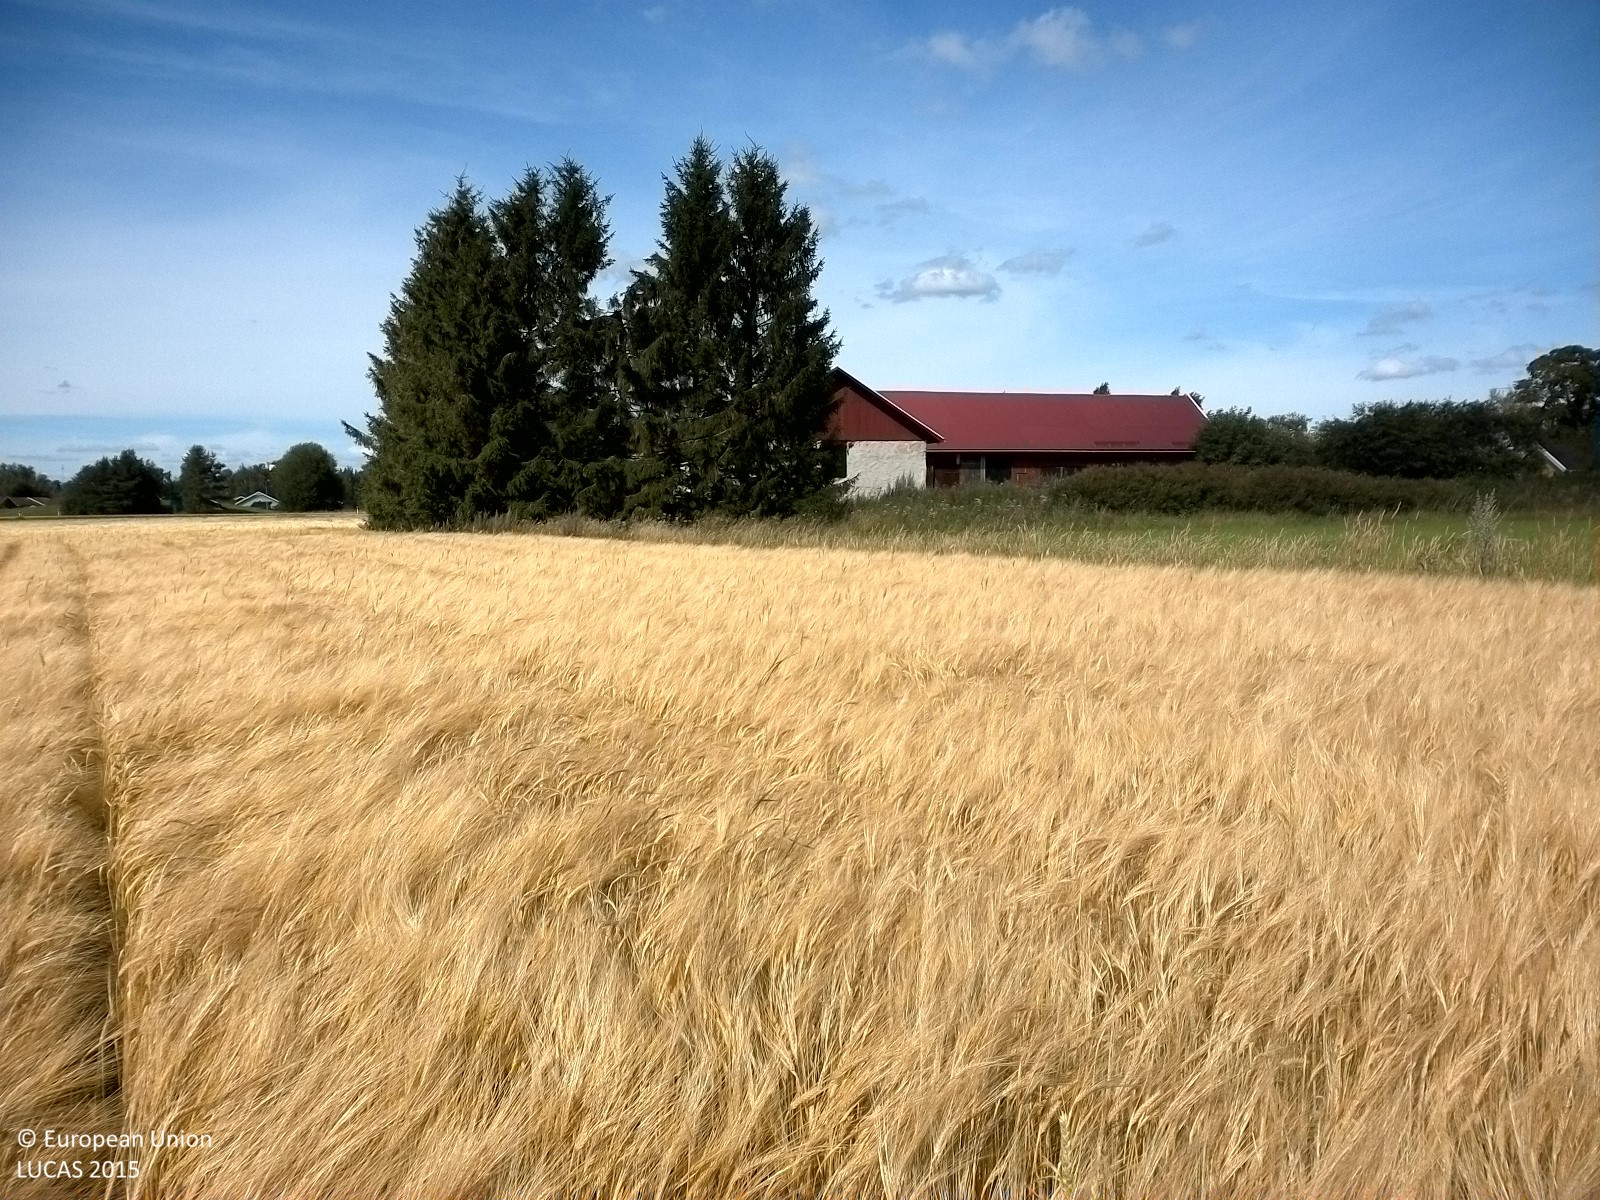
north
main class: Cropland
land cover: Barley
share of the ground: > 75 %
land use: Agriculture (excluding fallow land and kitchen gardens)
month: August
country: SE
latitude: 59.1518
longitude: 15.5348
